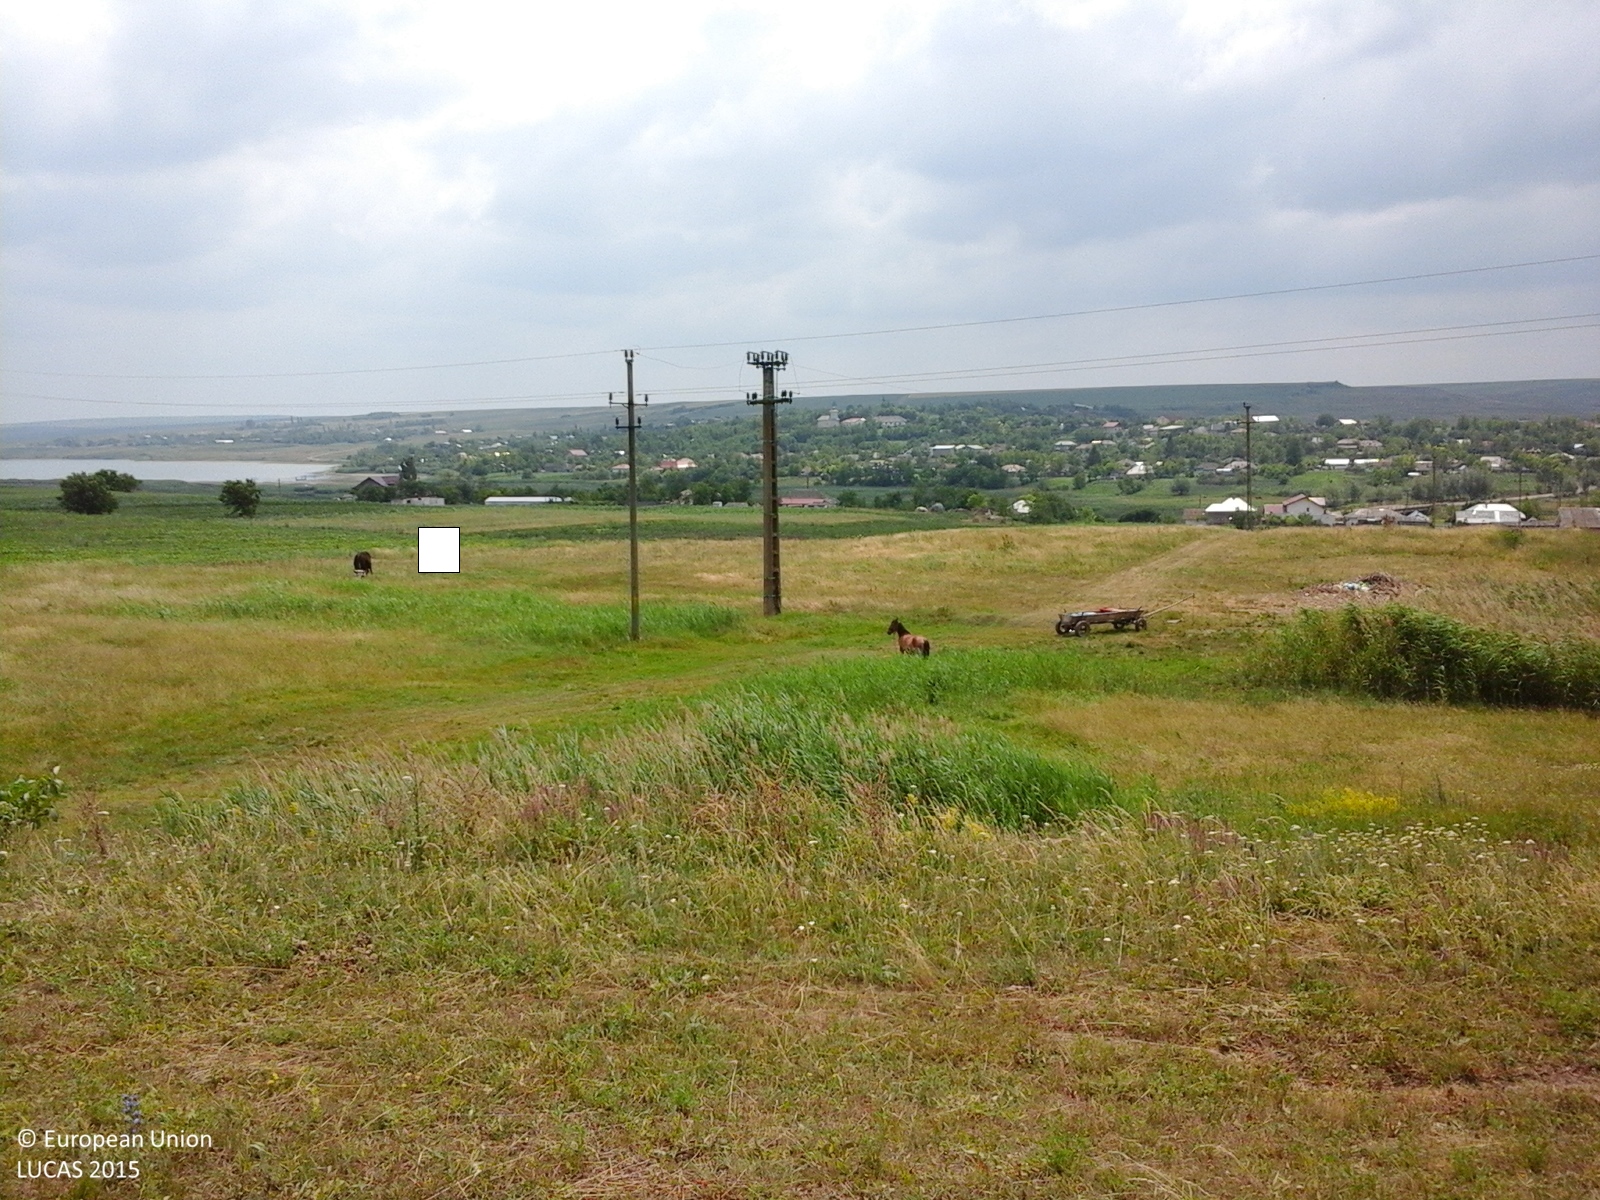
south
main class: Grassland
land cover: Grassland without tree/shrub cover
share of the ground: > 75 %
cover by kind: herbaceous plants 100 %
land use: Agriculture (excluding fallow land and kitchen gardens)
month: June
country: RO
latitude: 48.0590
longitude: 26.6958
